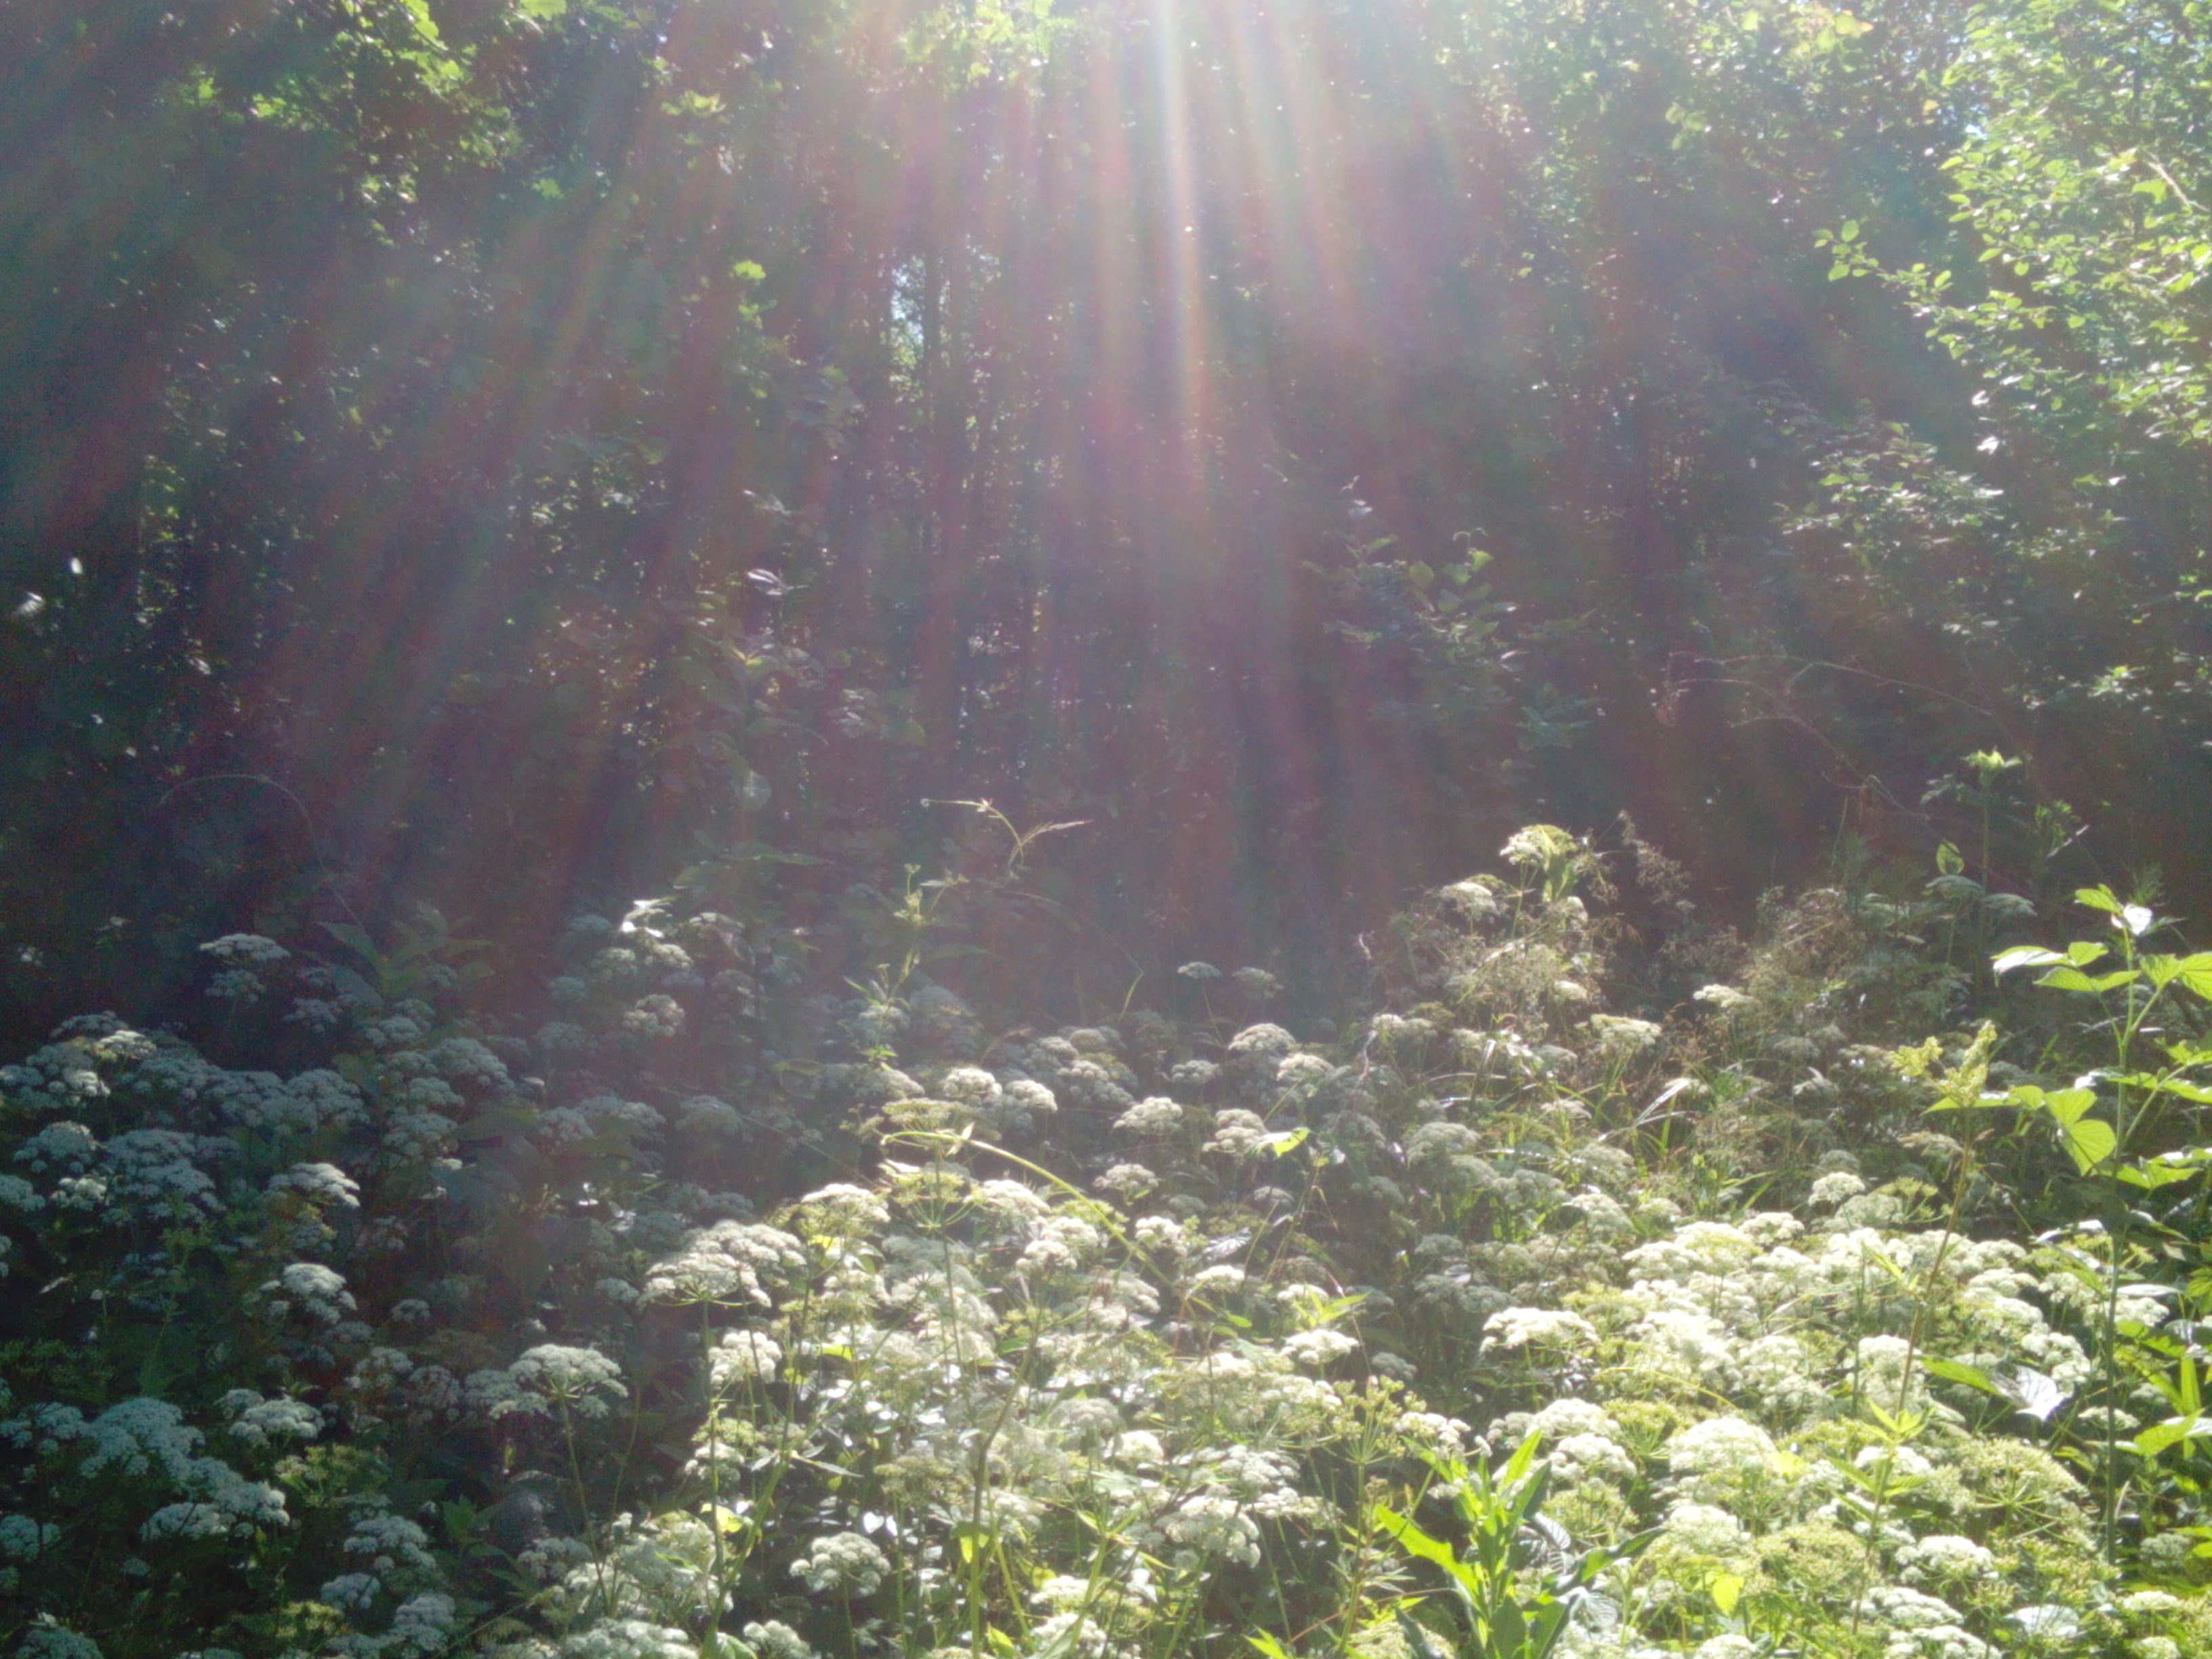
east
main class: Woodland
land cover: Broadleaved woodland
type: non-riverine alder, birch or aspen forest
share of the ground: 50 - 75 %
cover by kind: broadleaved forest trees 70 %, herbaceous plants 30 %
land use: Forestry
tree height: > 5 m
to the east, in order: Broadleaved woodland; Grassland without tree/shrub cover; Broadleaved woodland; Rivers and streams; Broadleaved woodland; Tracks; Strawberries
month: July
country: LV
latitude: 56.4349
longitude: 22.0679
